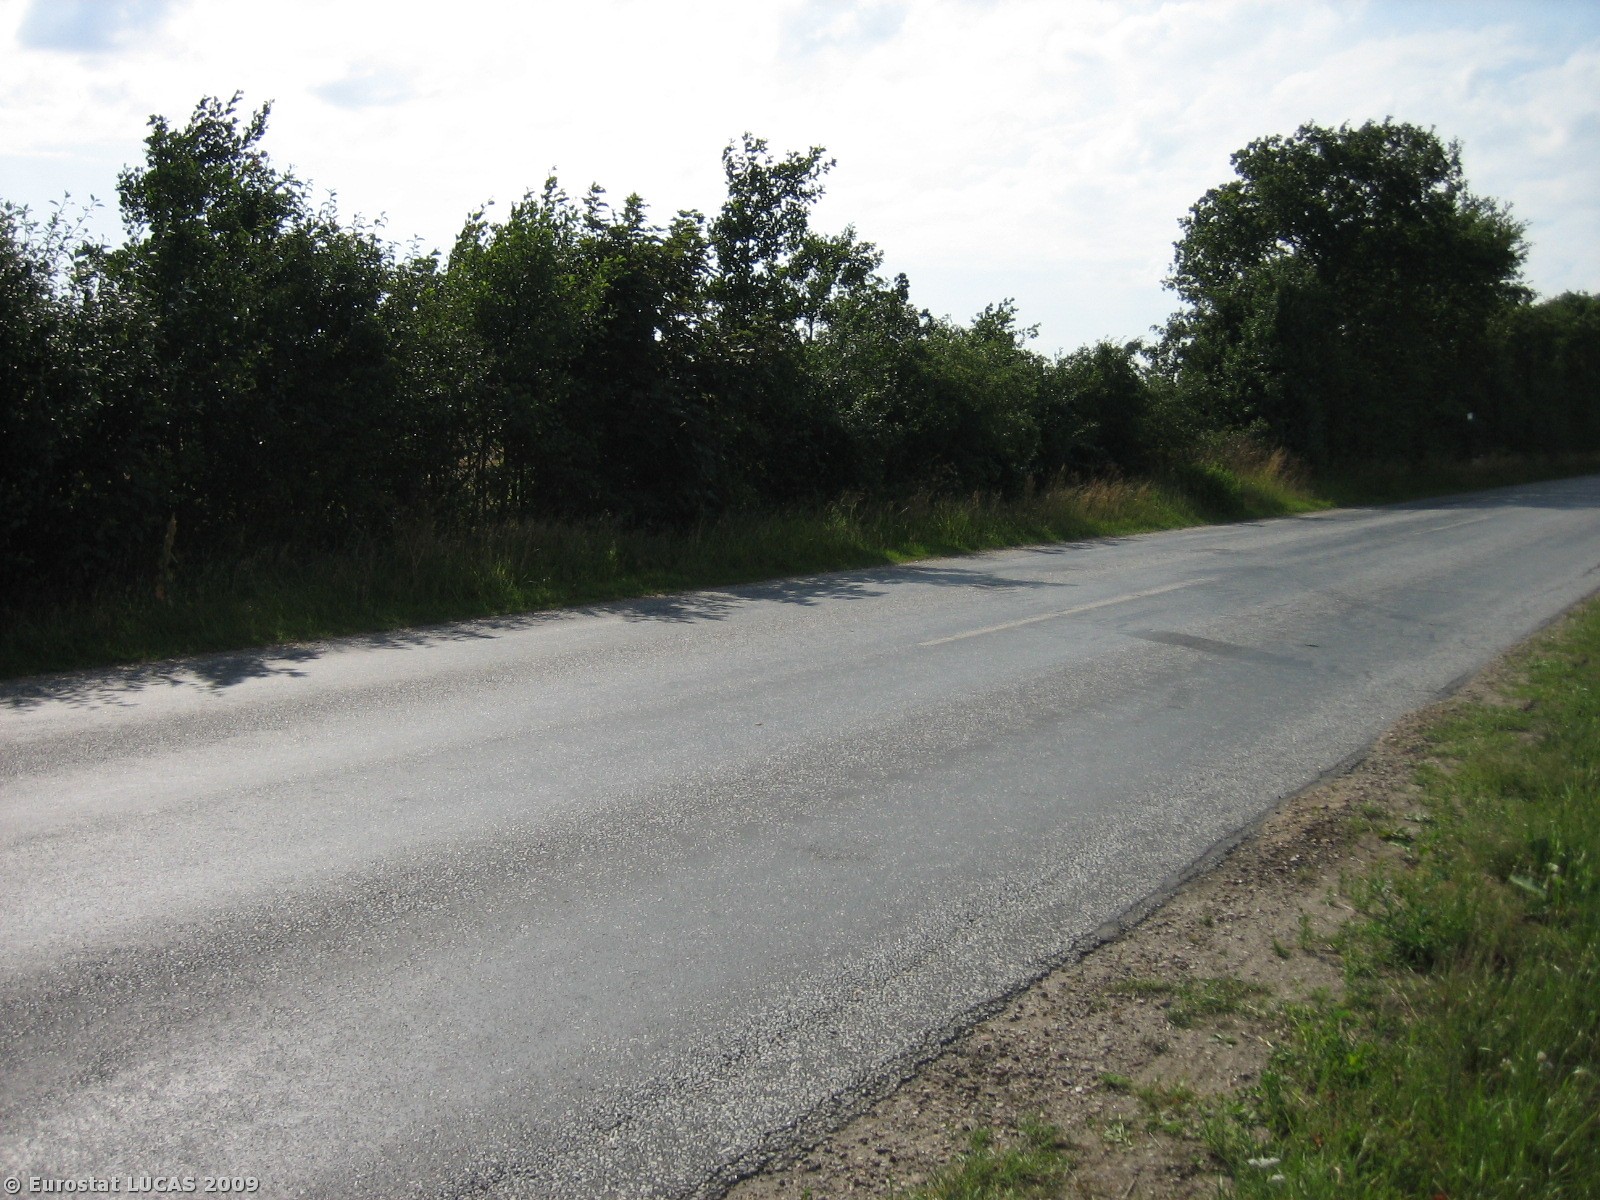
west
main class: Cropland
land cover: Barley
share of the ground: > 75 %
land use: Agriculture (excluding fallow land and kitchen gardens)
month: July
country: DK
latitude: 55.7693
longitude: 8.8694
